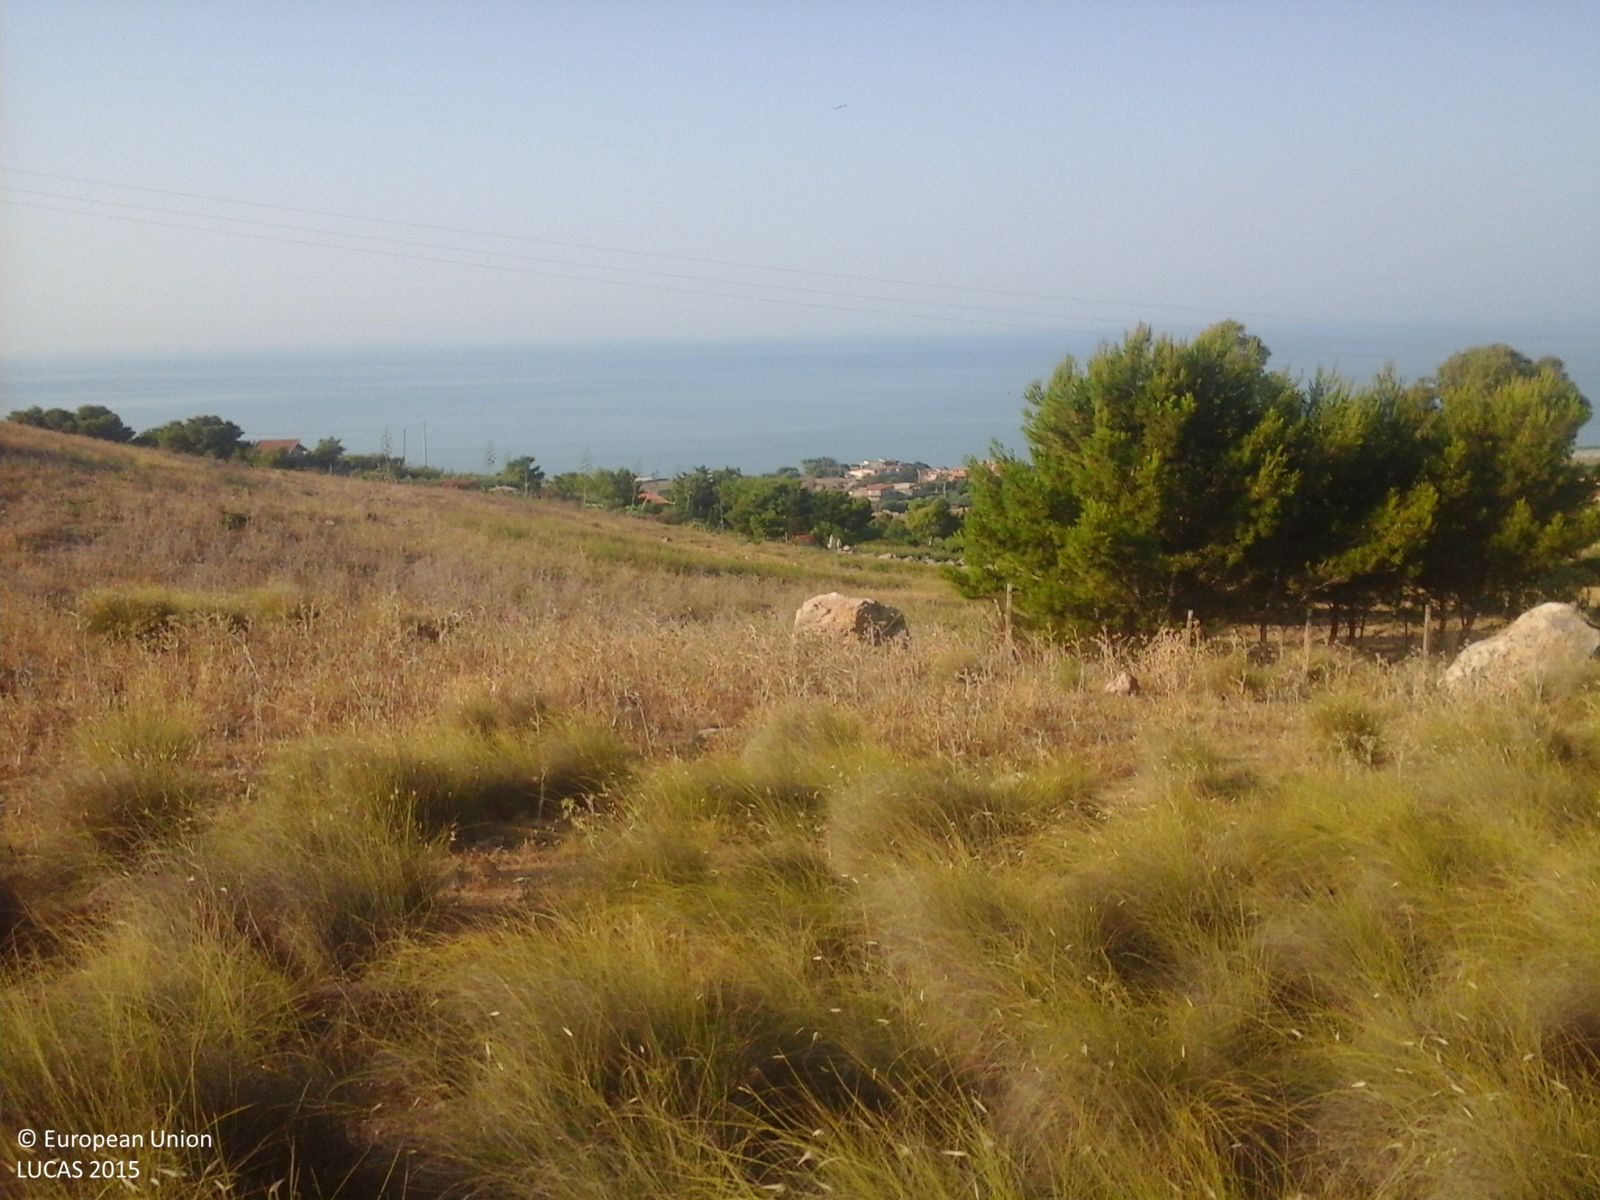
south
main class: Grassland
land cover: Grassland without tree/shrub cover
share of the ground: > 75 %
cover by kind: herbaceous plants 100 %
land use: Semi-natural and natural areas not in use
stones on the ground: < 10 %
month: July
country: IT
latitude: 37.1176
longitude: 14.0086
